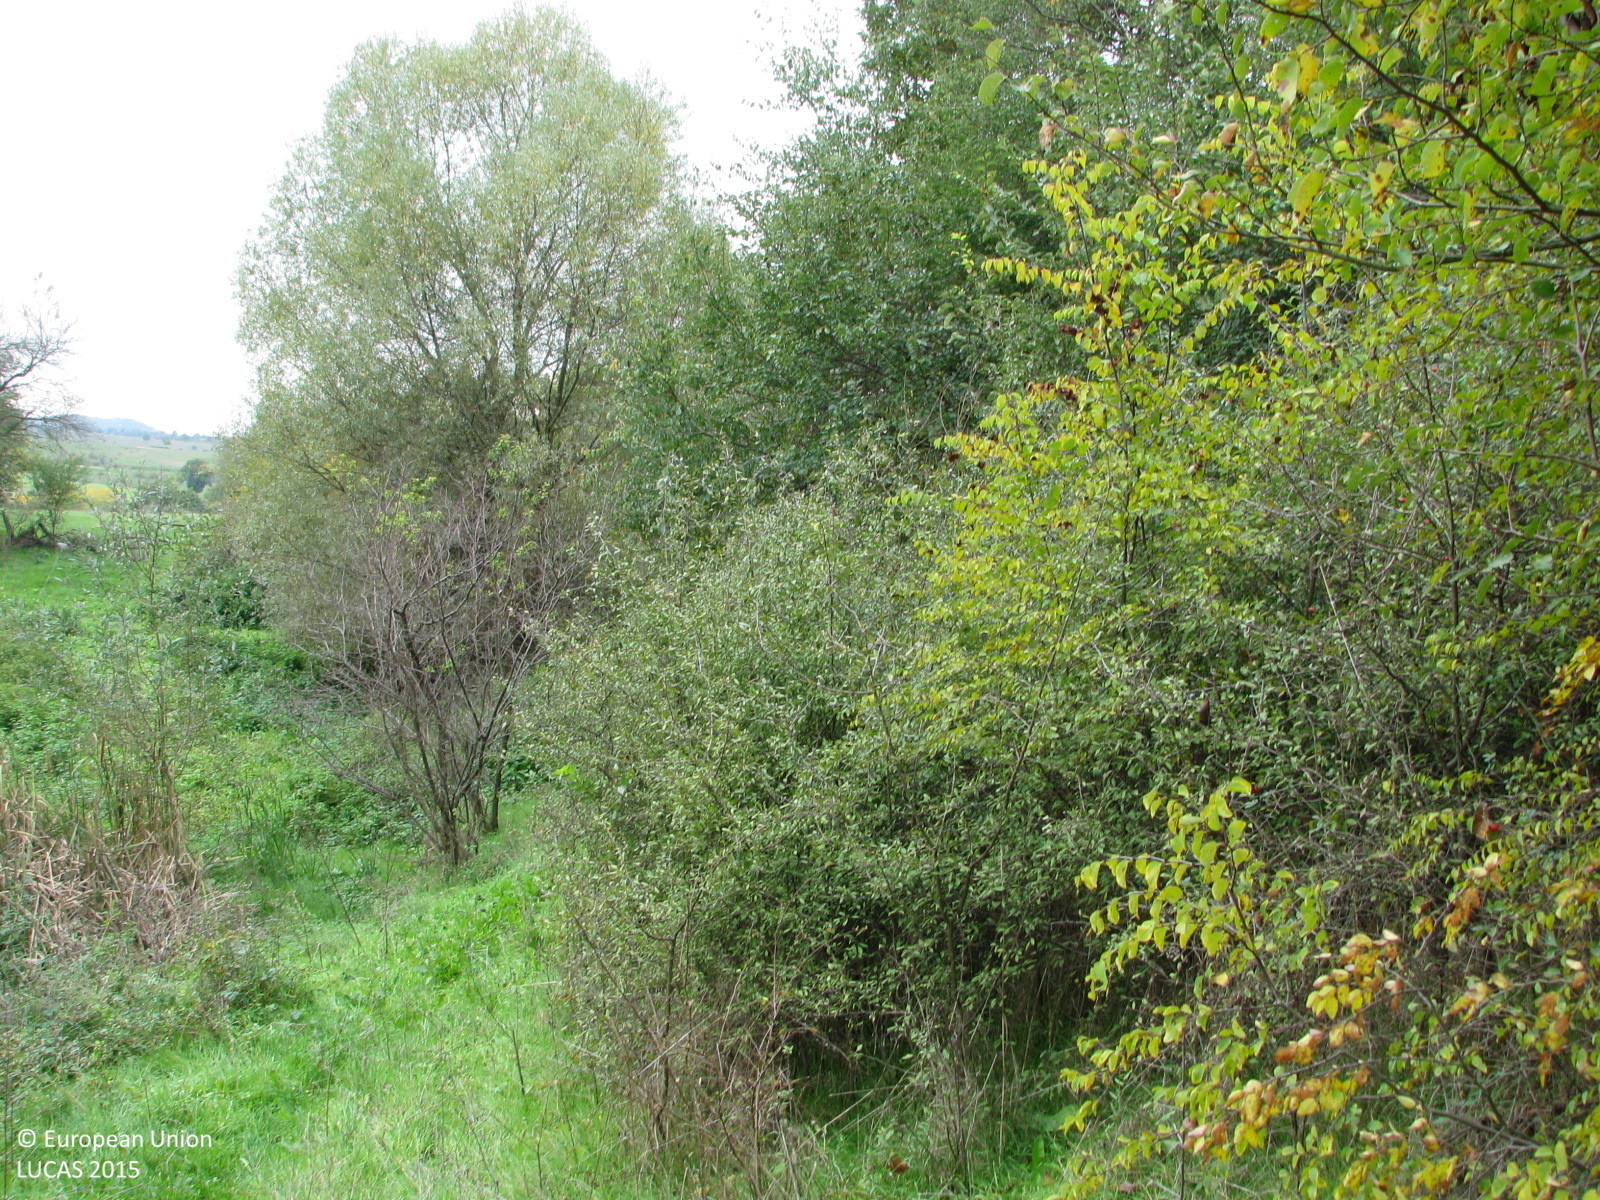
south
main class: Woodland
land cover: Broadleaved woodland
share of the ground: 50 - 75 %
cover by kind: broadleaved forest trees 60 %, shrubs 20 %, herbaceous plants 20 %
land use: Agriculture (excluding fallow land and kitchen gardens)
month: October
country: BG
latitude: 41.9963
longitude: 26.5656
